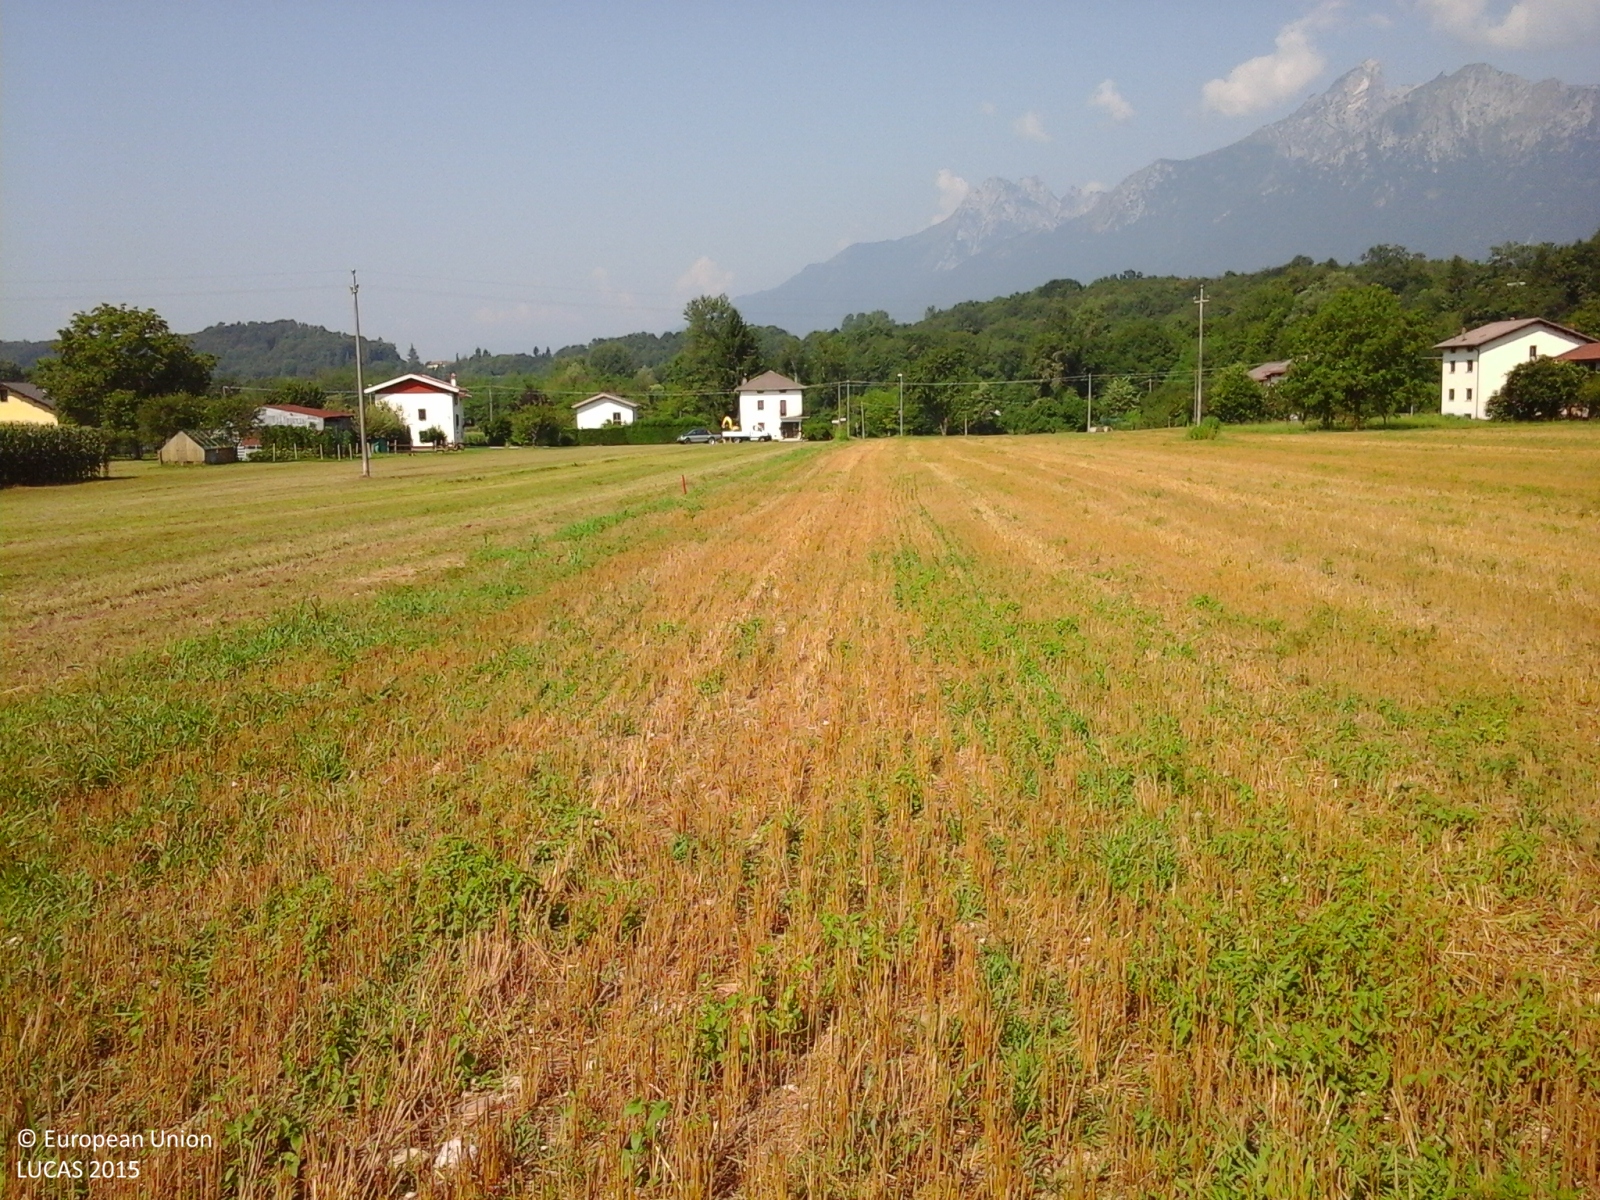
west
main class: Cropland
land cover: Common wheat
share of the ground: > 75 %
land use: Agriculture (excluding fallow land and kitchen gardens)
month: July
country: IT
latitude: 46.1317
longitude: 12.1329
